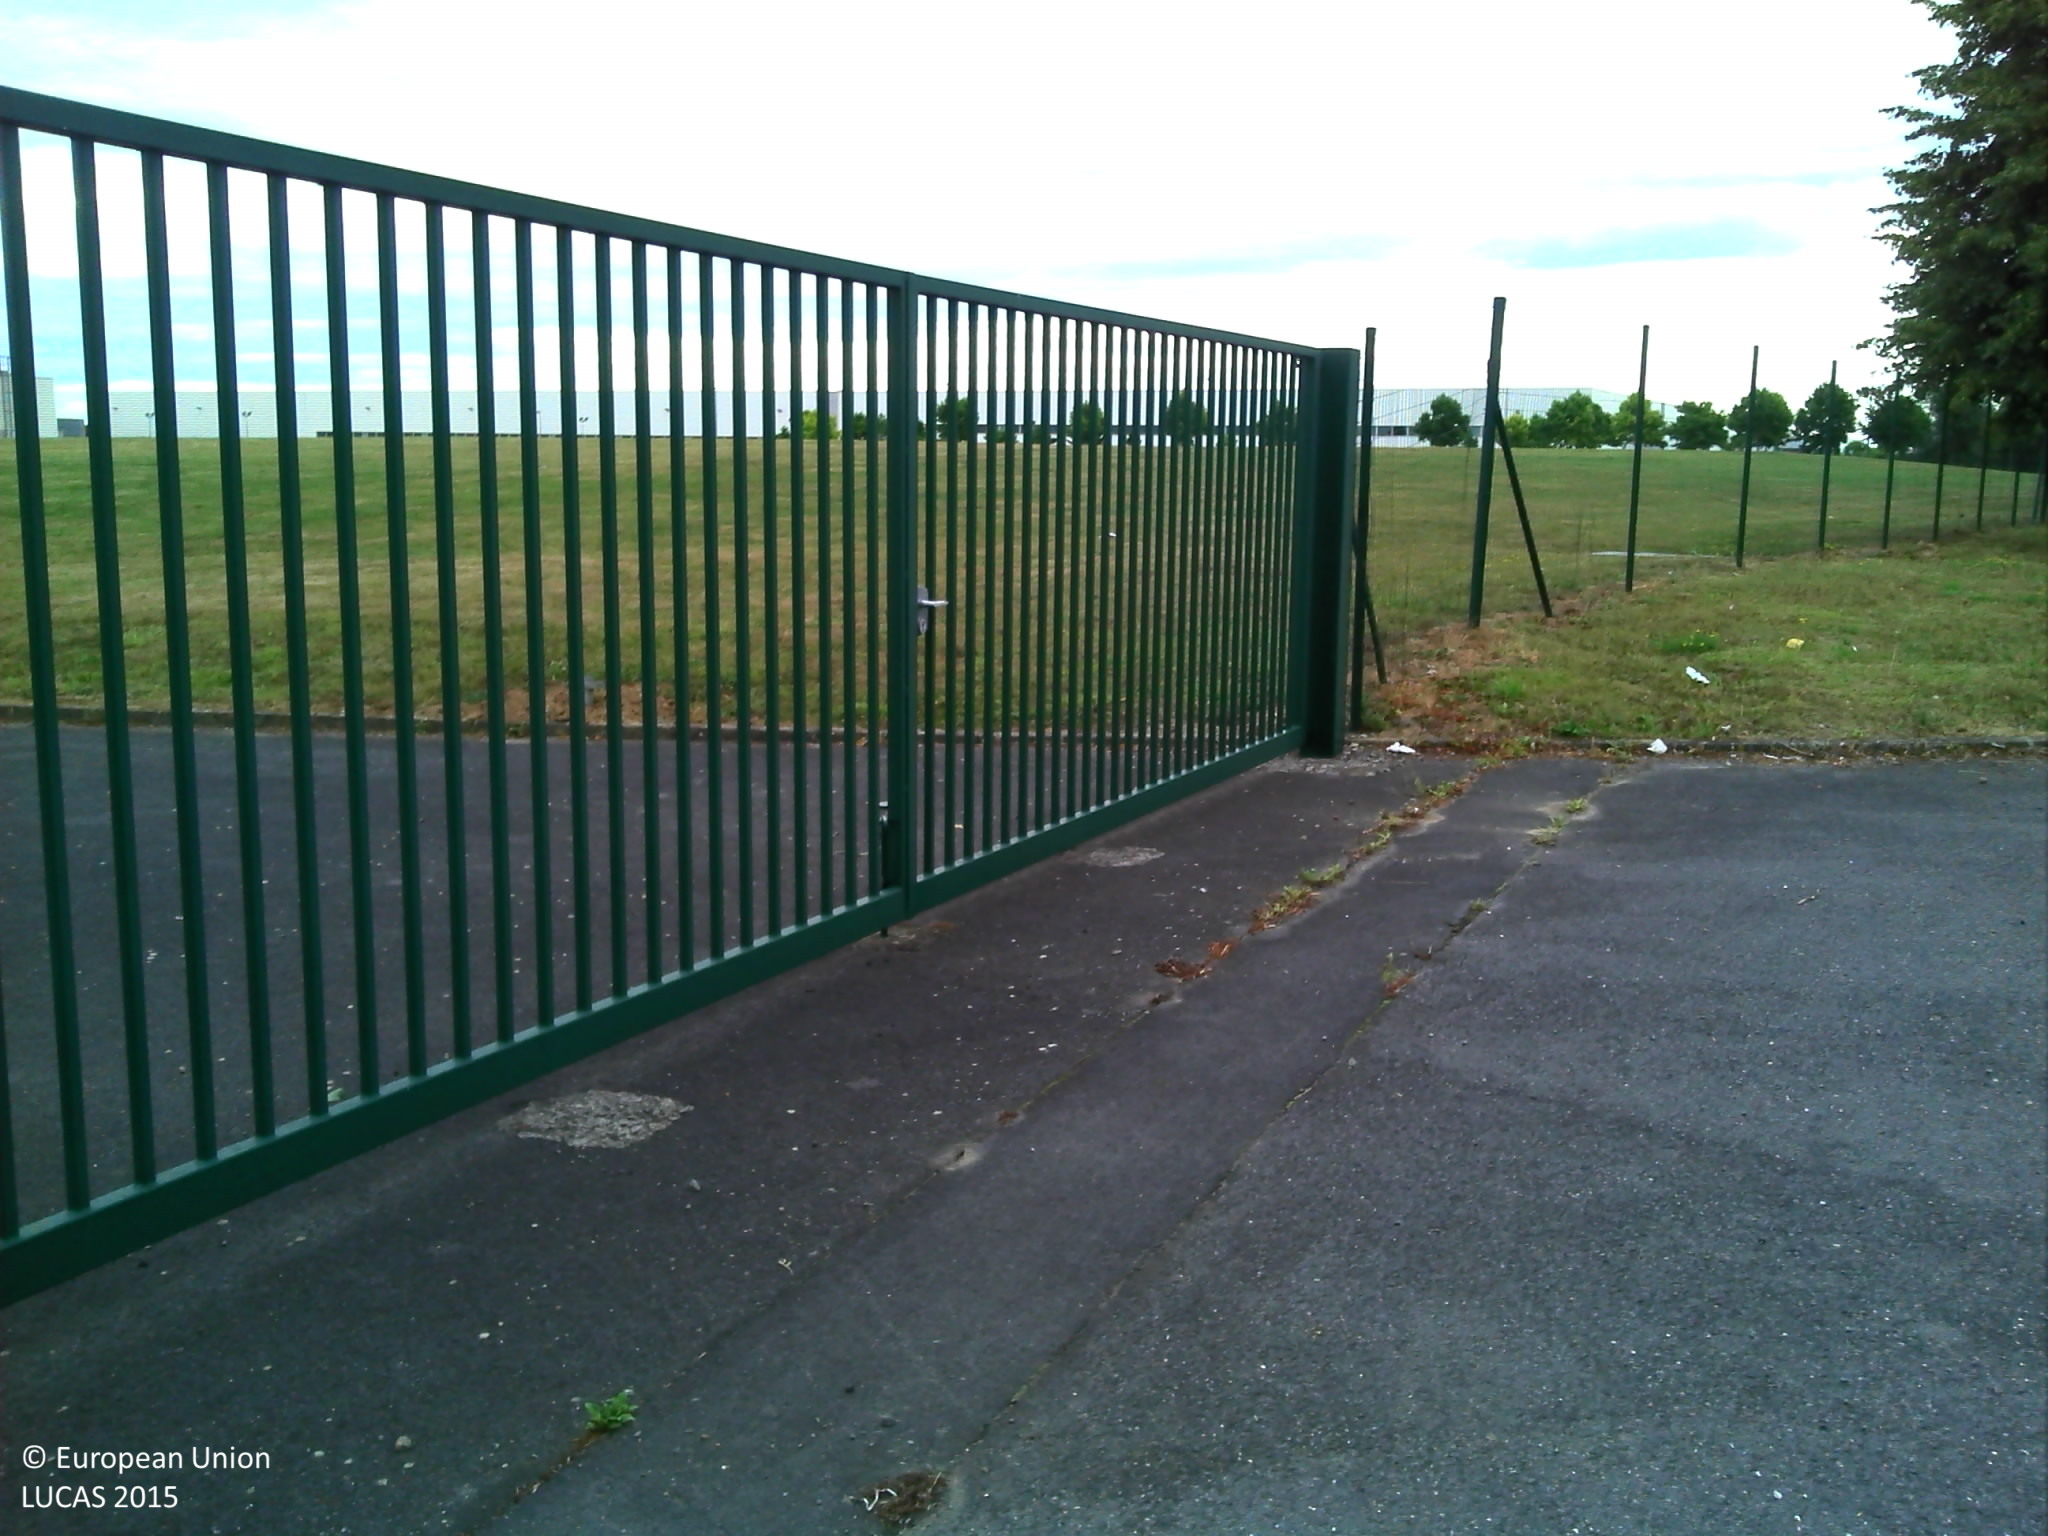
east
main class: Grassland
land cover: Grassland without tree/shrub cover
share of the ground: > 75 %
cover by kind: herbaceous plants 95 %, lichens and mosses 5 %
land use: Machinery and equipment
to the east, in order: Grassland without tree/shrub cover; Artificial constructions in urban areas; Grassland without tree/shrub cover; Artificial constructions in urban areas
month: July
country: FR
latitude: 50.1975
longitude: 3.1968
